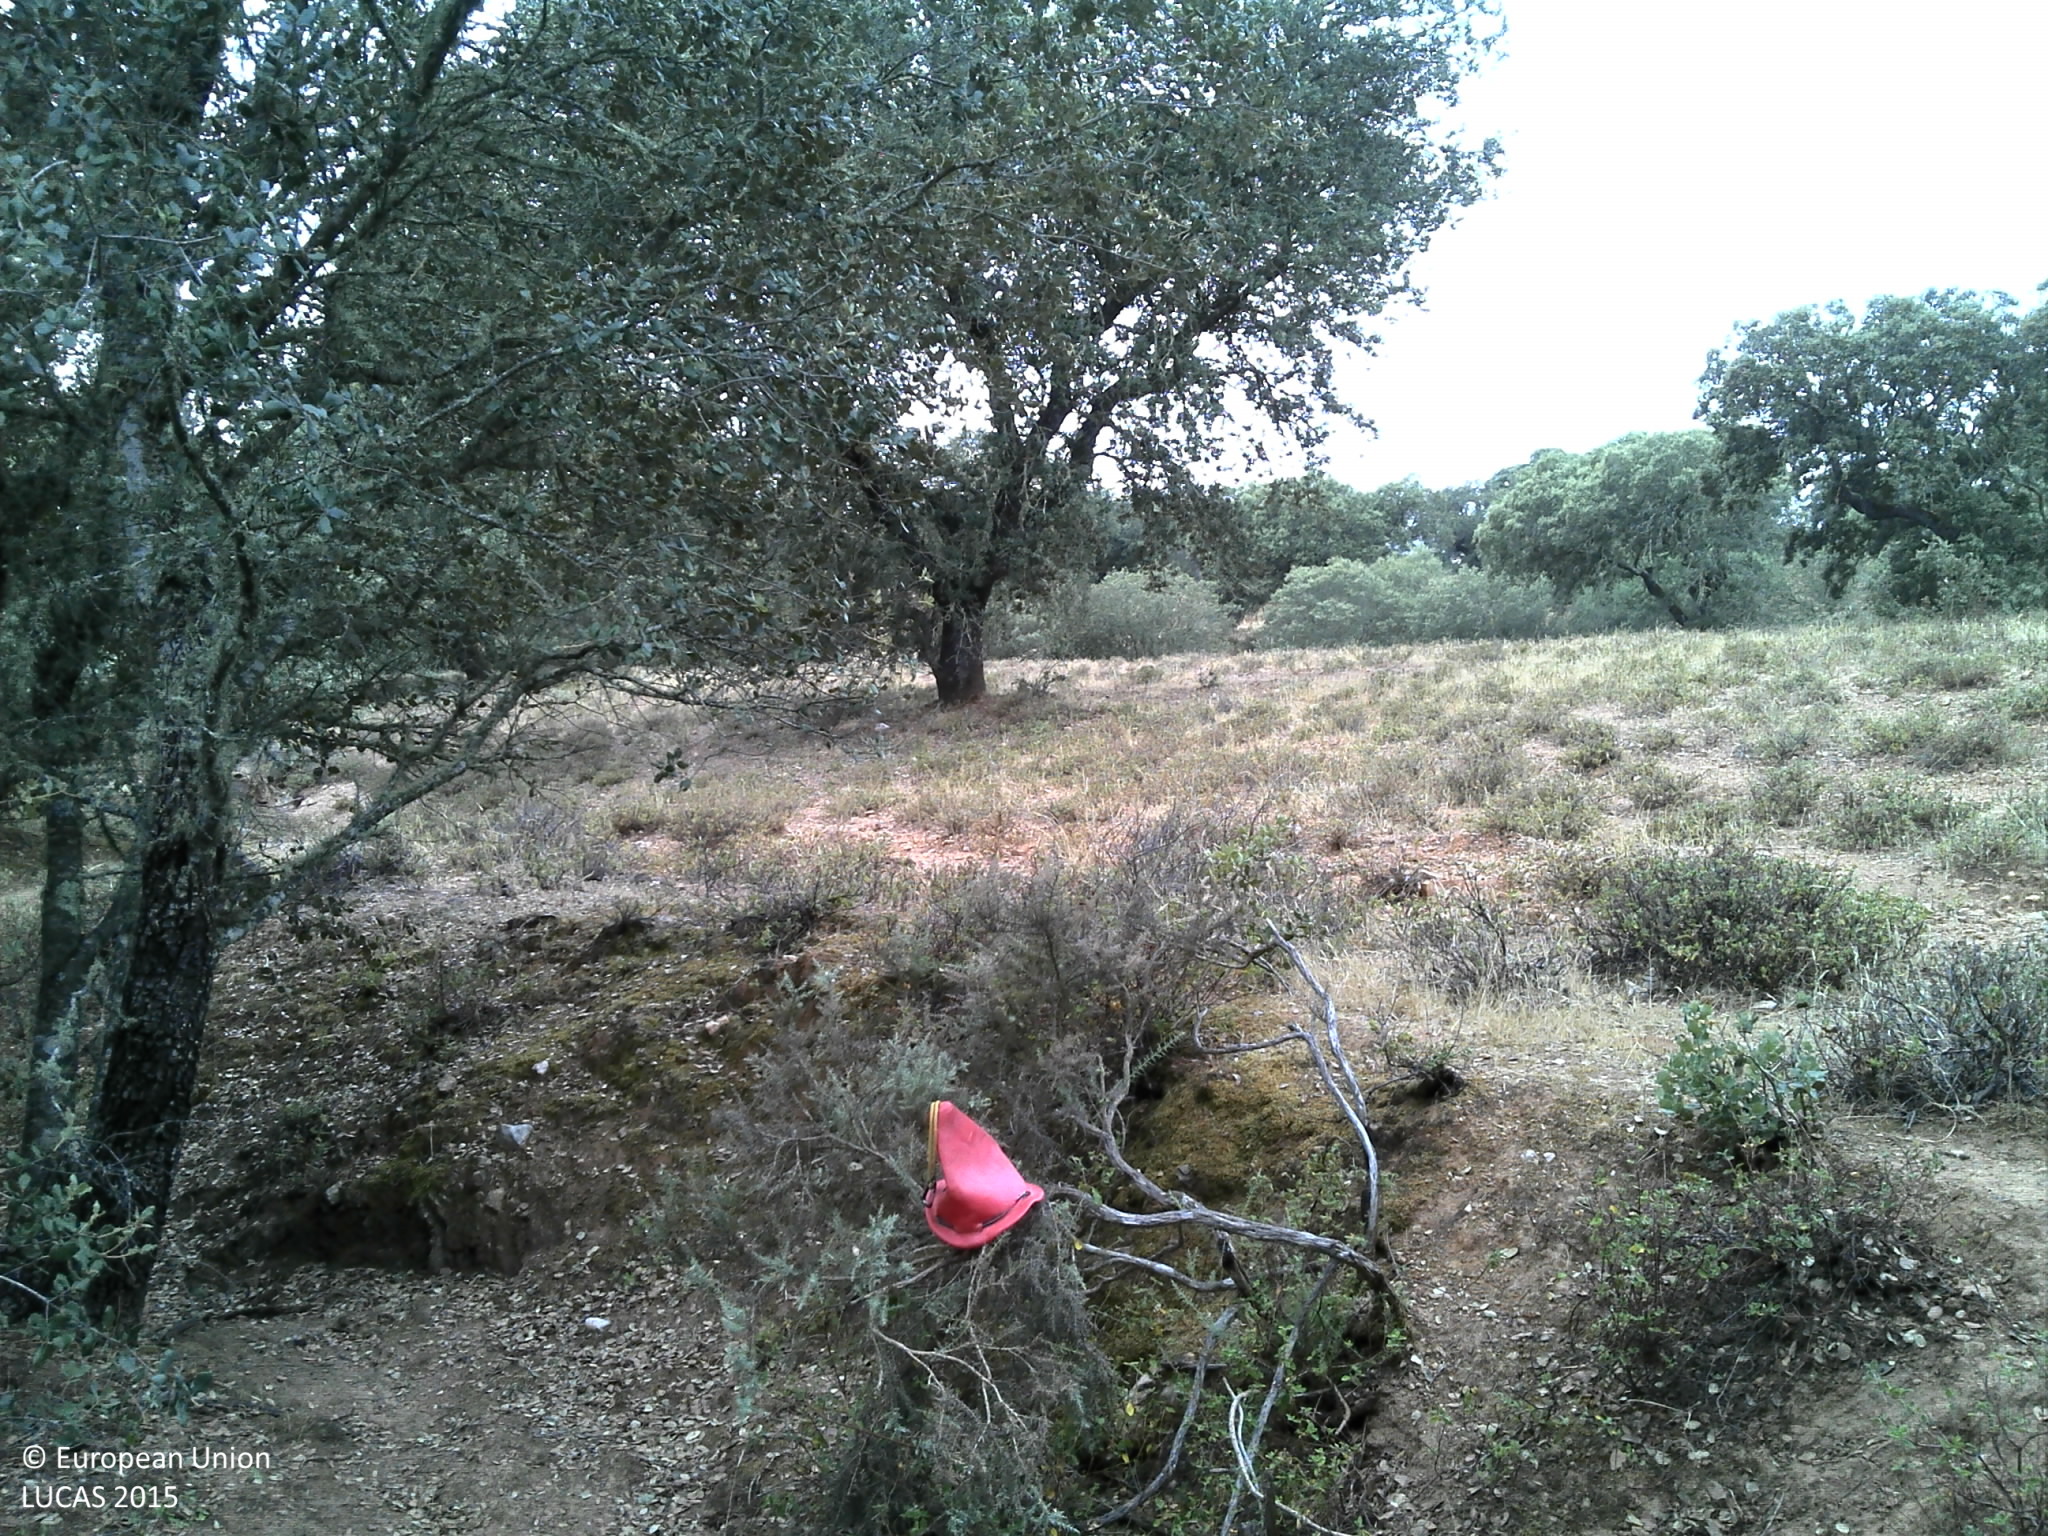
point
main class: Woodland
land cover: Broadleaved woodland
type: broadleaved evergreen forest
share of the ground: 25 - 50 %
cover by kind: broadleaved forest trees 50 %, shrubs 20 %, herbaceous plants 20 %, unconsolidated bare surface 10 %
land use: Forestry
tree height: > 5 m
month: June
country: PT
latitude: 38.6754
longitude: -7.7269
